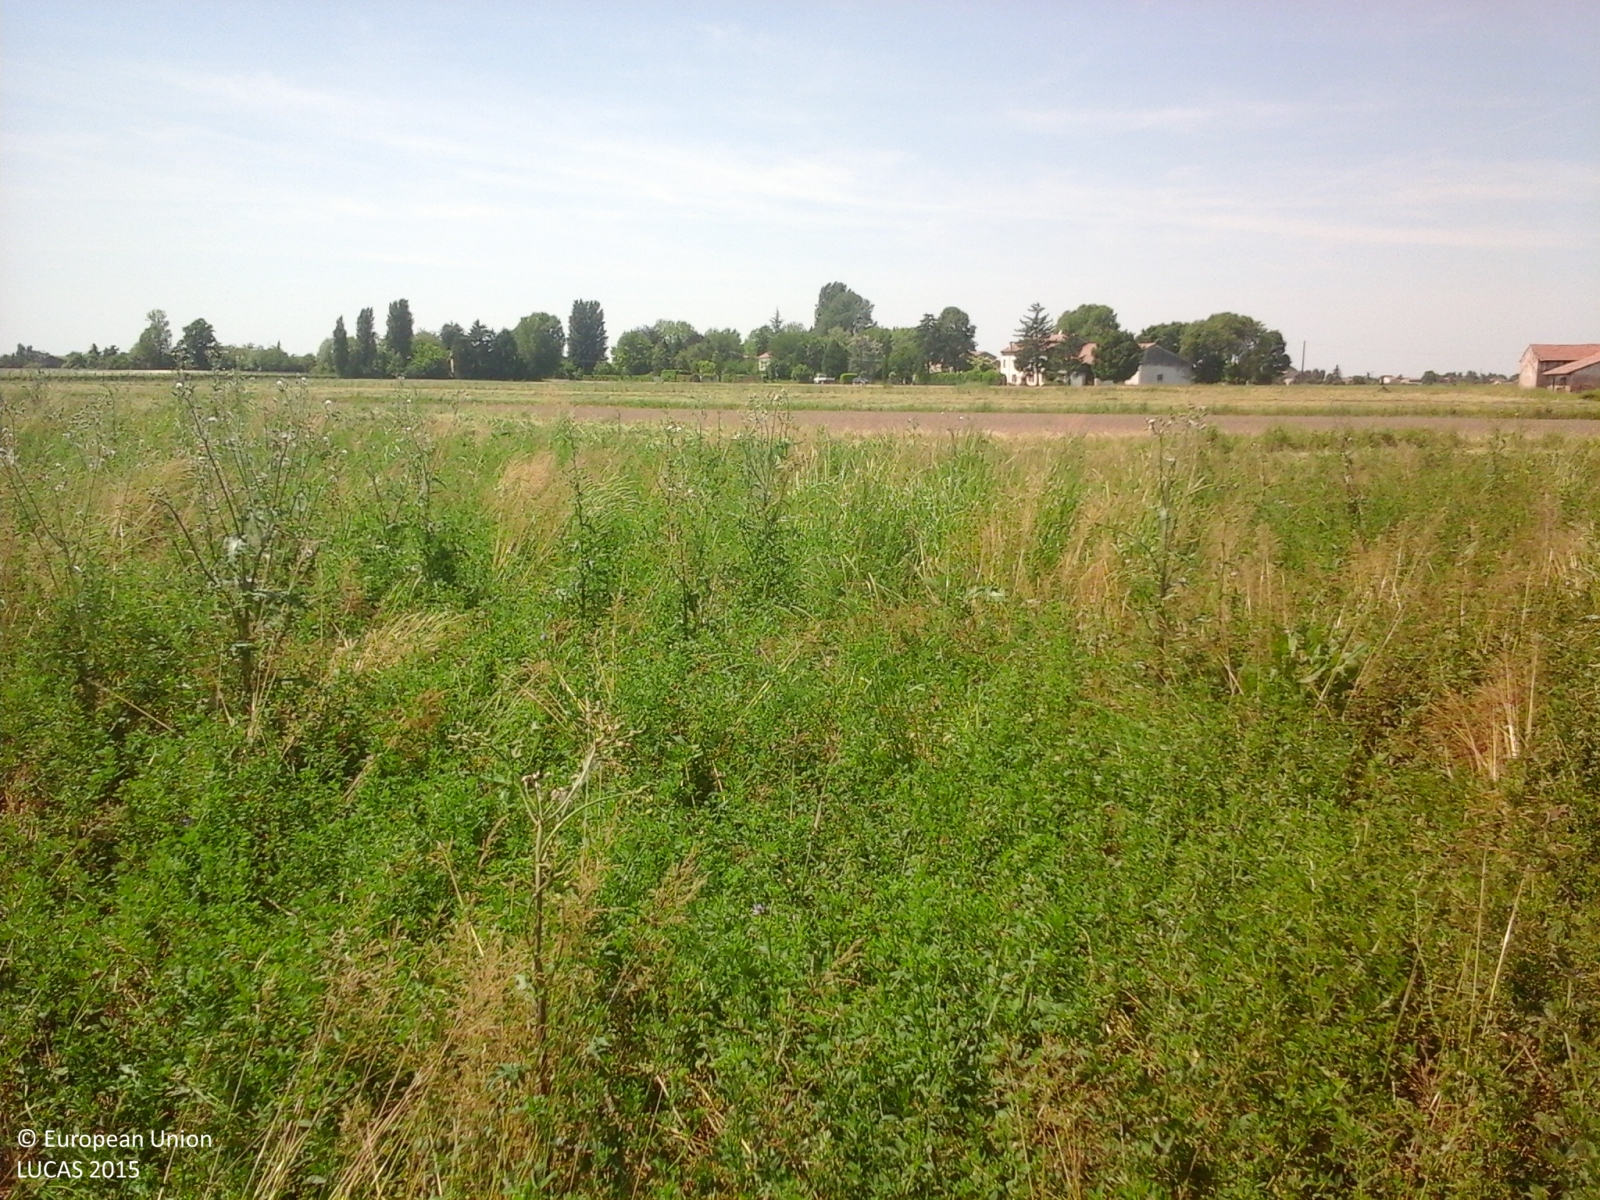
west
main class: Cropland
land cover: Lucerne
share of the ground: > 75 %
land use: Agriculture (excluding fallow land and kitchen gardens)
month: May
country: IT
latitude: 44.9759
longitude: 11.1011
